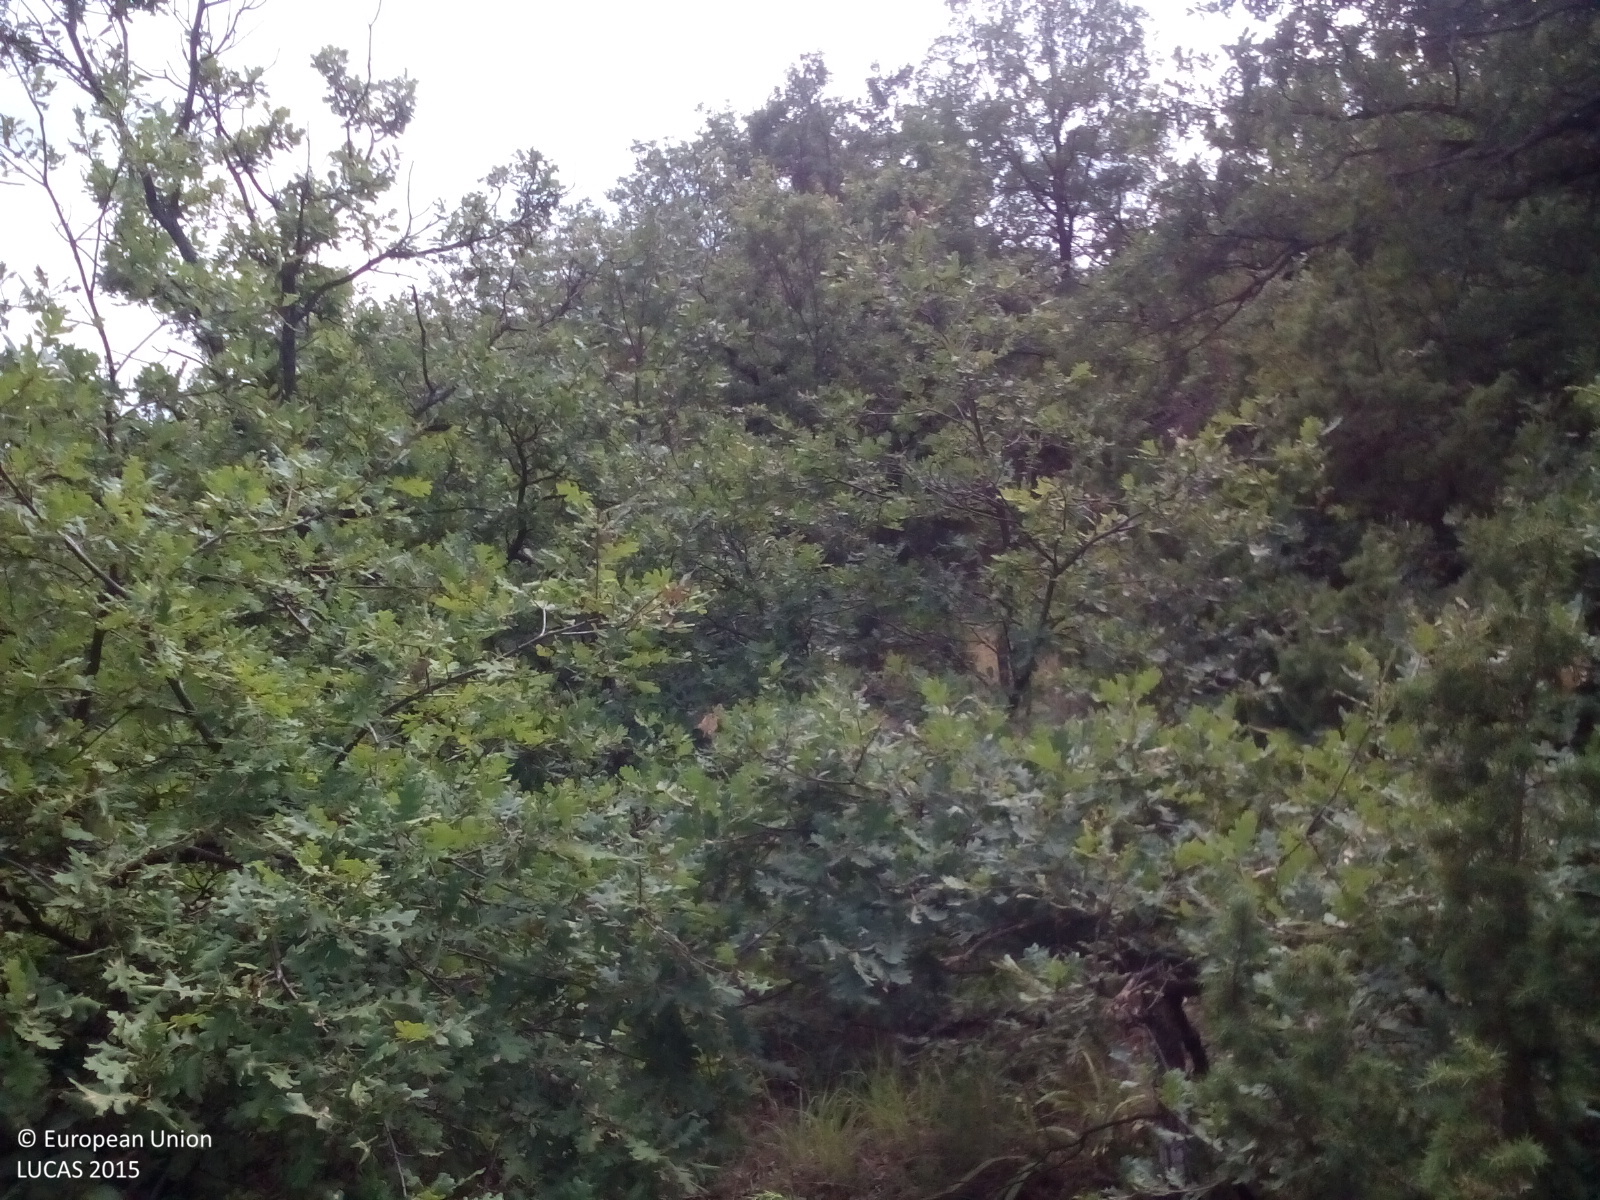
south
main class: Woodland
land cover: Broadleaved woodland
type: thermophilous deciduous forest
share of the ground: 50 - 75 %
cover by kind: broadleaved forest trees 60 %, herbaceous plants 30 %, shrubs 10 %
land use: Semi-natural and natural areas not in use
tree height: > 5 m
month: August
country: GR
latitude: 40.8039
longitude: 21.4088
